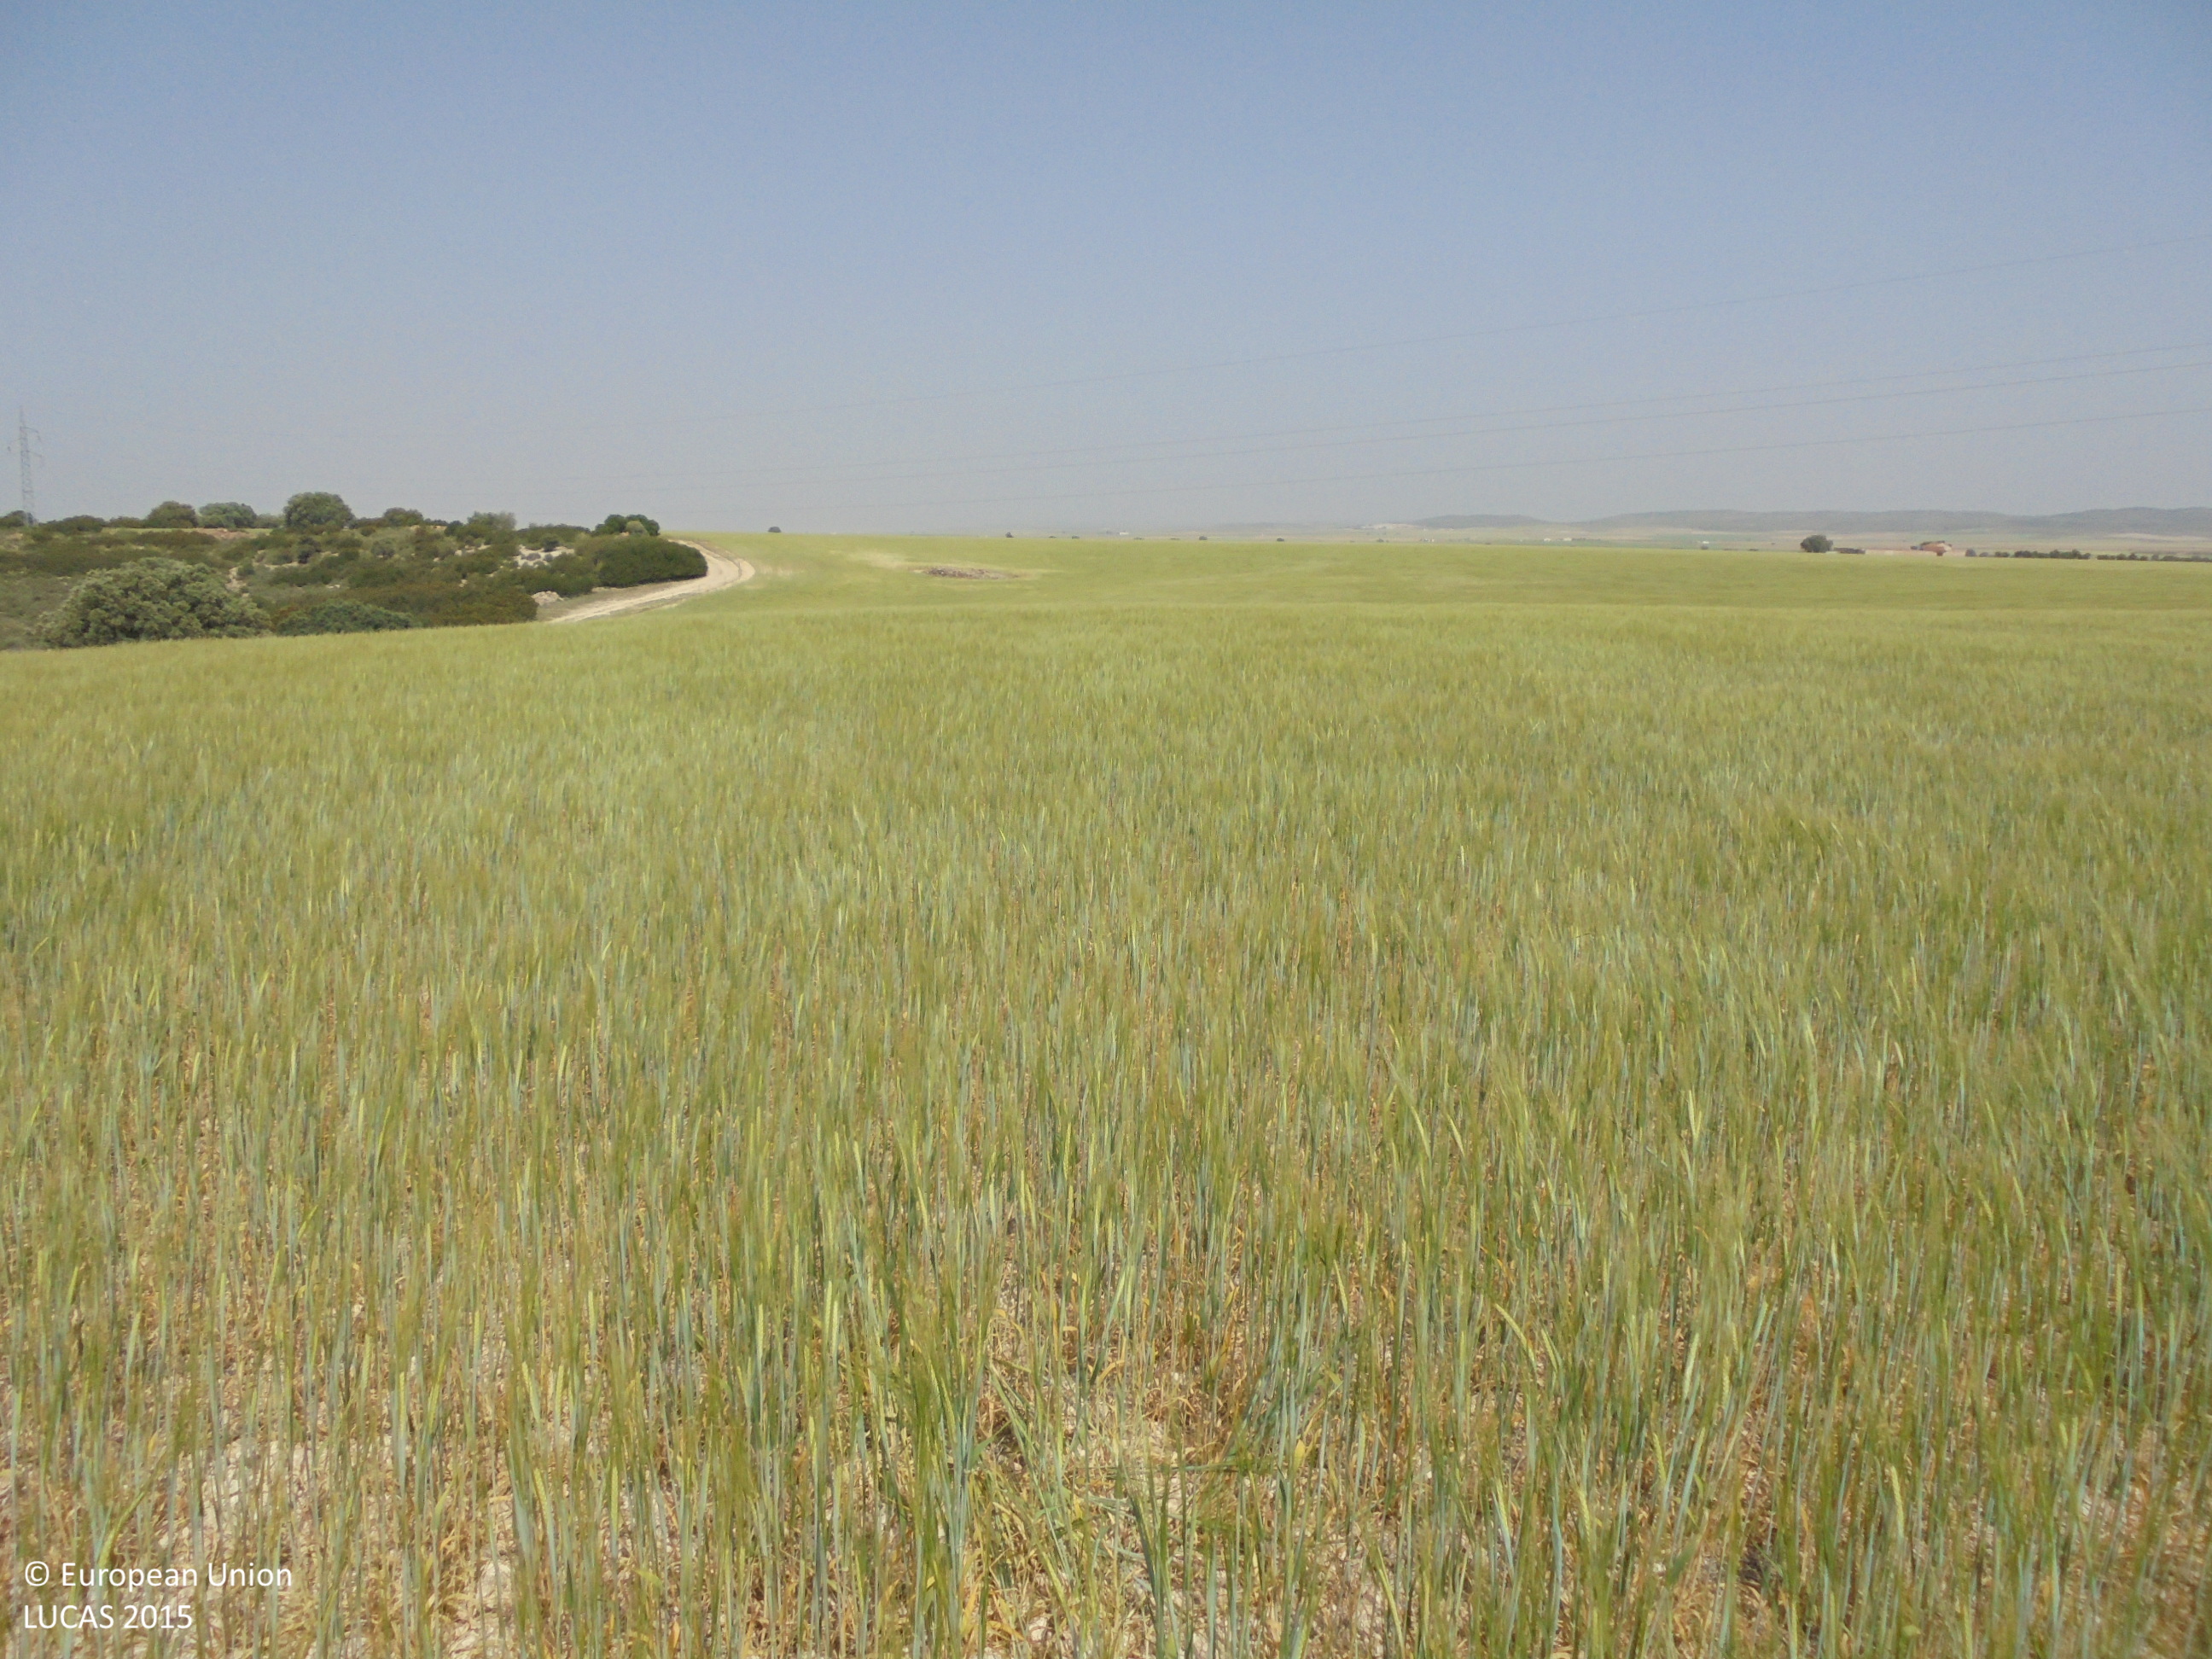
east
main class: Cropland
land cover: Barley
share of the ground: 50 - 75 %
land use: Agriculture (excluding fallow land and kitchen gardens)
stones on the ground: > 50 %
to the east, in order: Barley; Electric lines; Barley
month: May
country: ES
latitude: 39.0704
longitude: -1.7087
